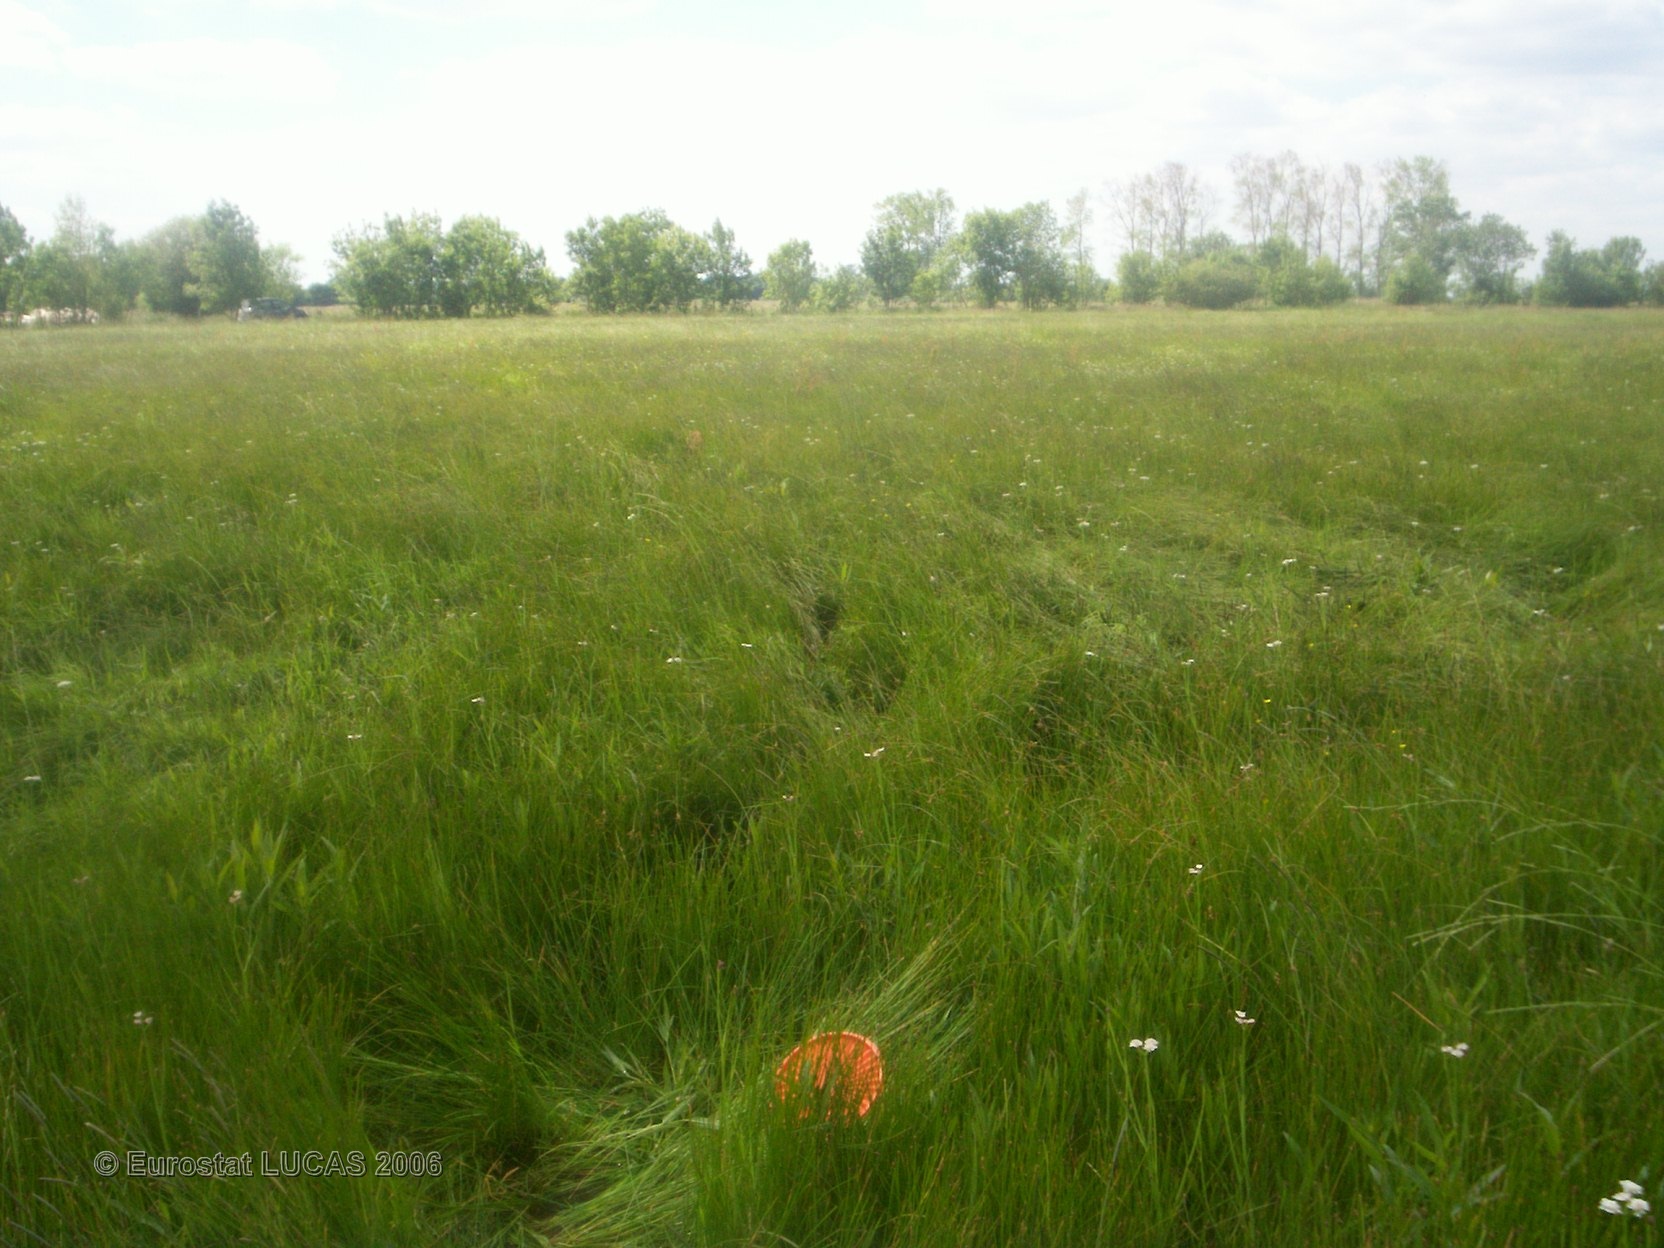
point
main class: Grassland
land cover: Grassland without tree/shrub cover
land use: Agriculture (excluding fallow land and kitchen gardens)
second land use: Wetland
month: May
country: FR
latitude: 45.8922
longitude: -0.8135
